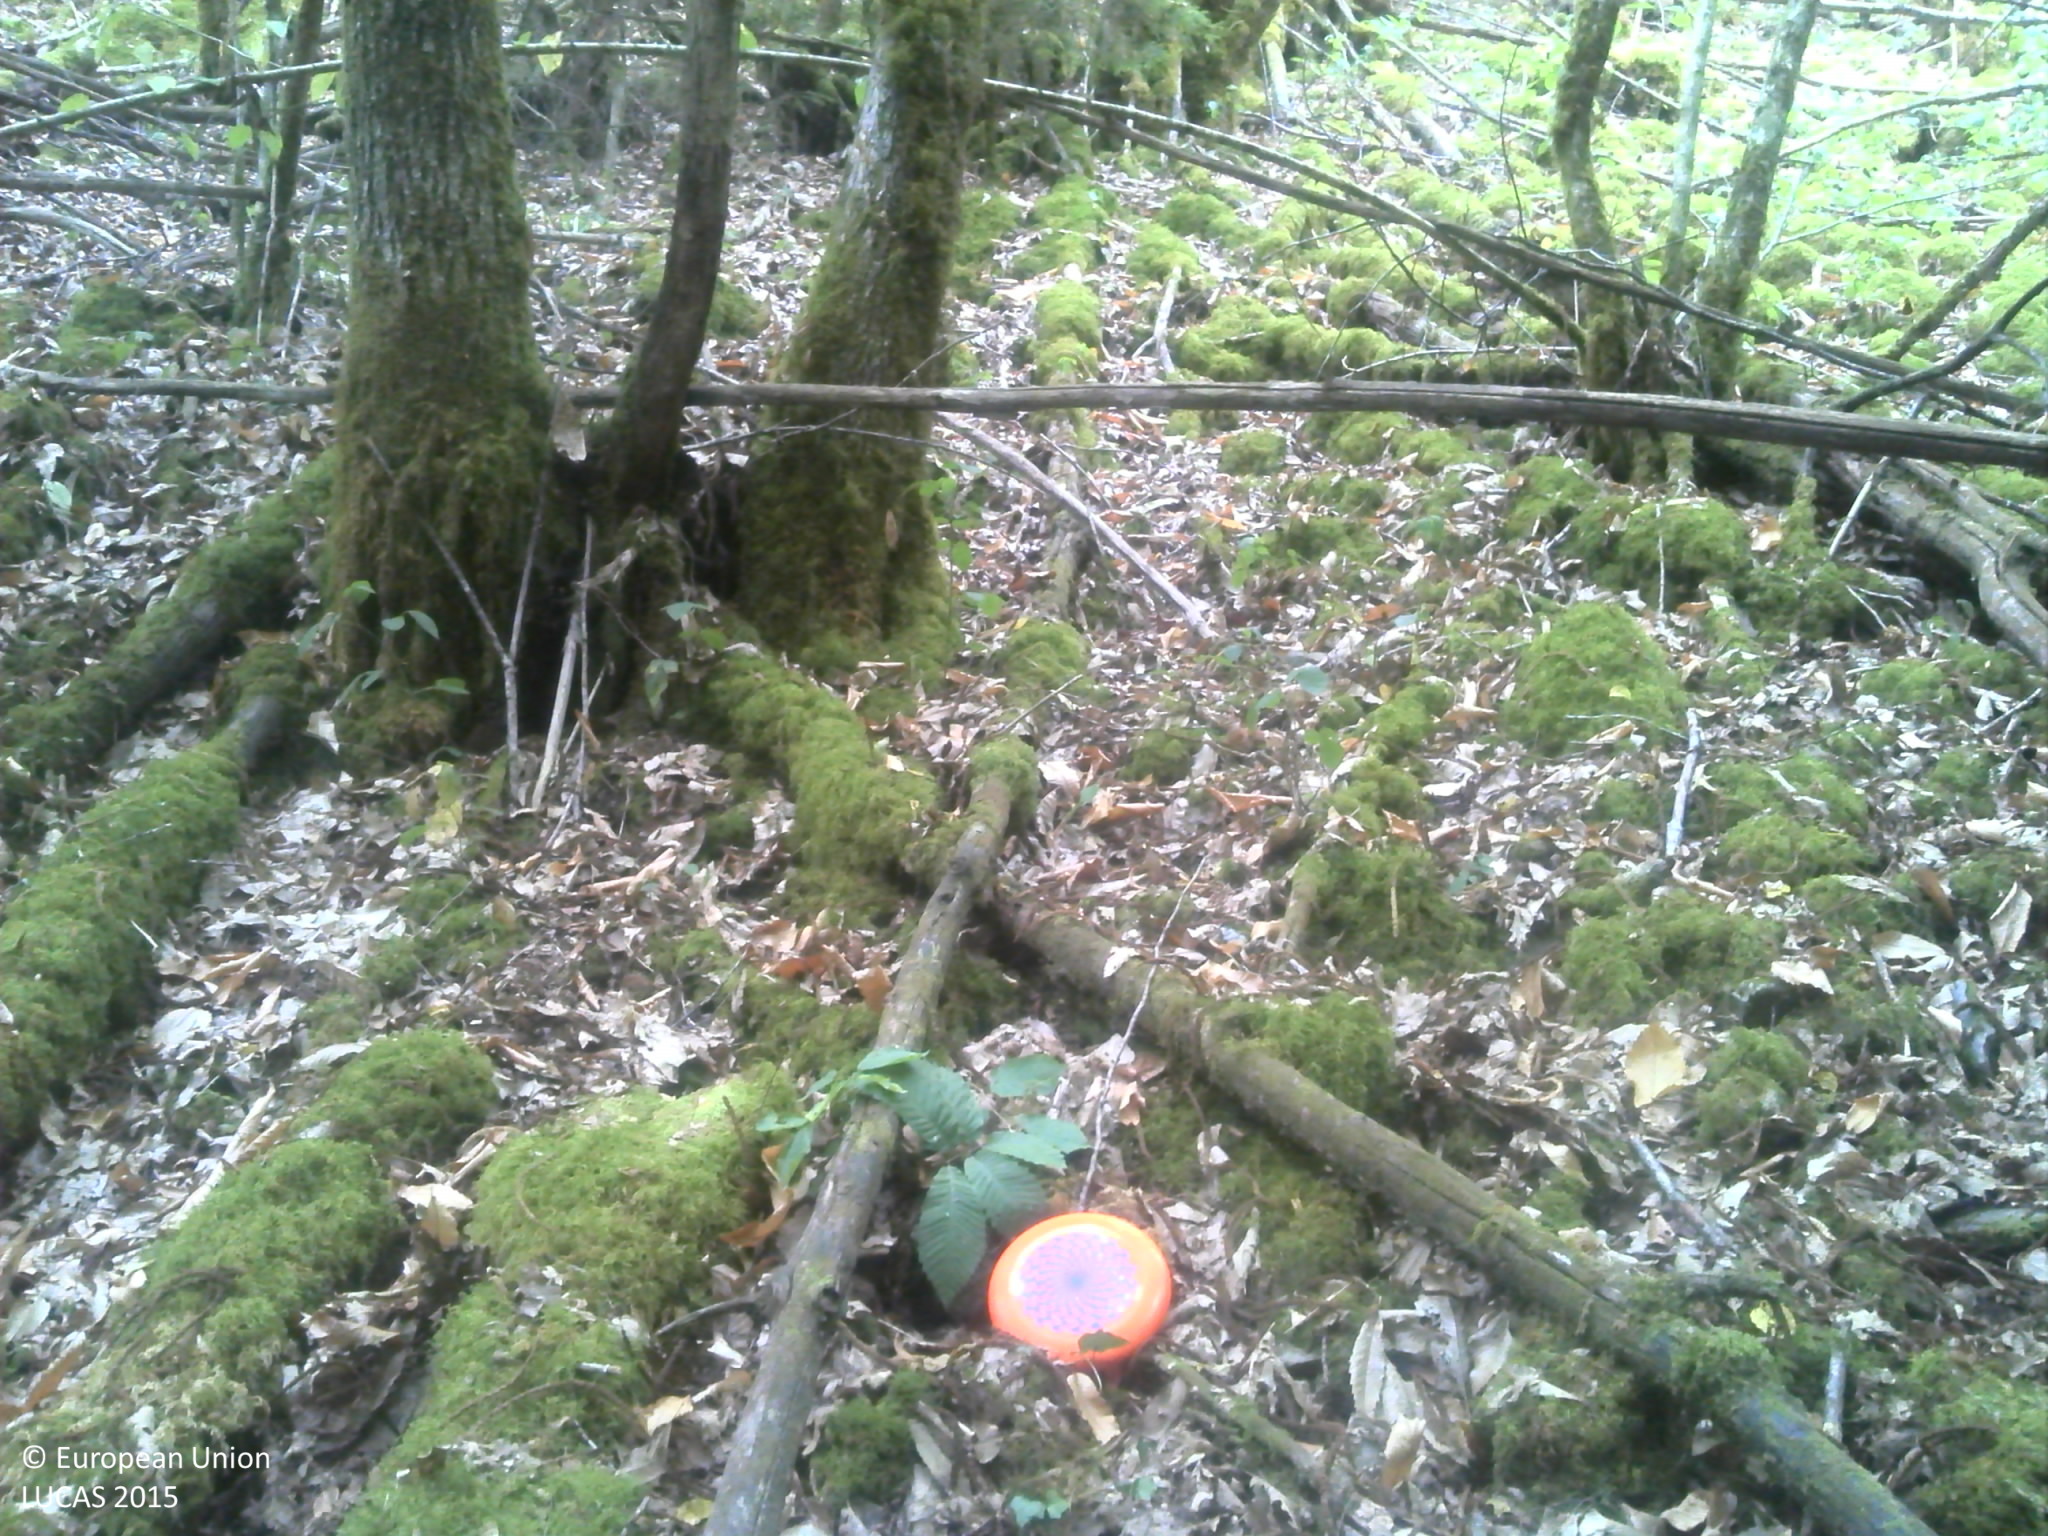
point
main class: Woodland
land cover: Pine dominated mixed woodland
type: mountainous beech forest
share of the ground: > 75 %
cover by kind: broadleaved forest trees 40 %, coniferous forest trees 35 %, lichens and mosses 20 %, herbaceous plants 5 %
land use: Forestry
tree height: > 5 m
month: July
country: FR
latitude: 45.1880
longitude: 1.8384
